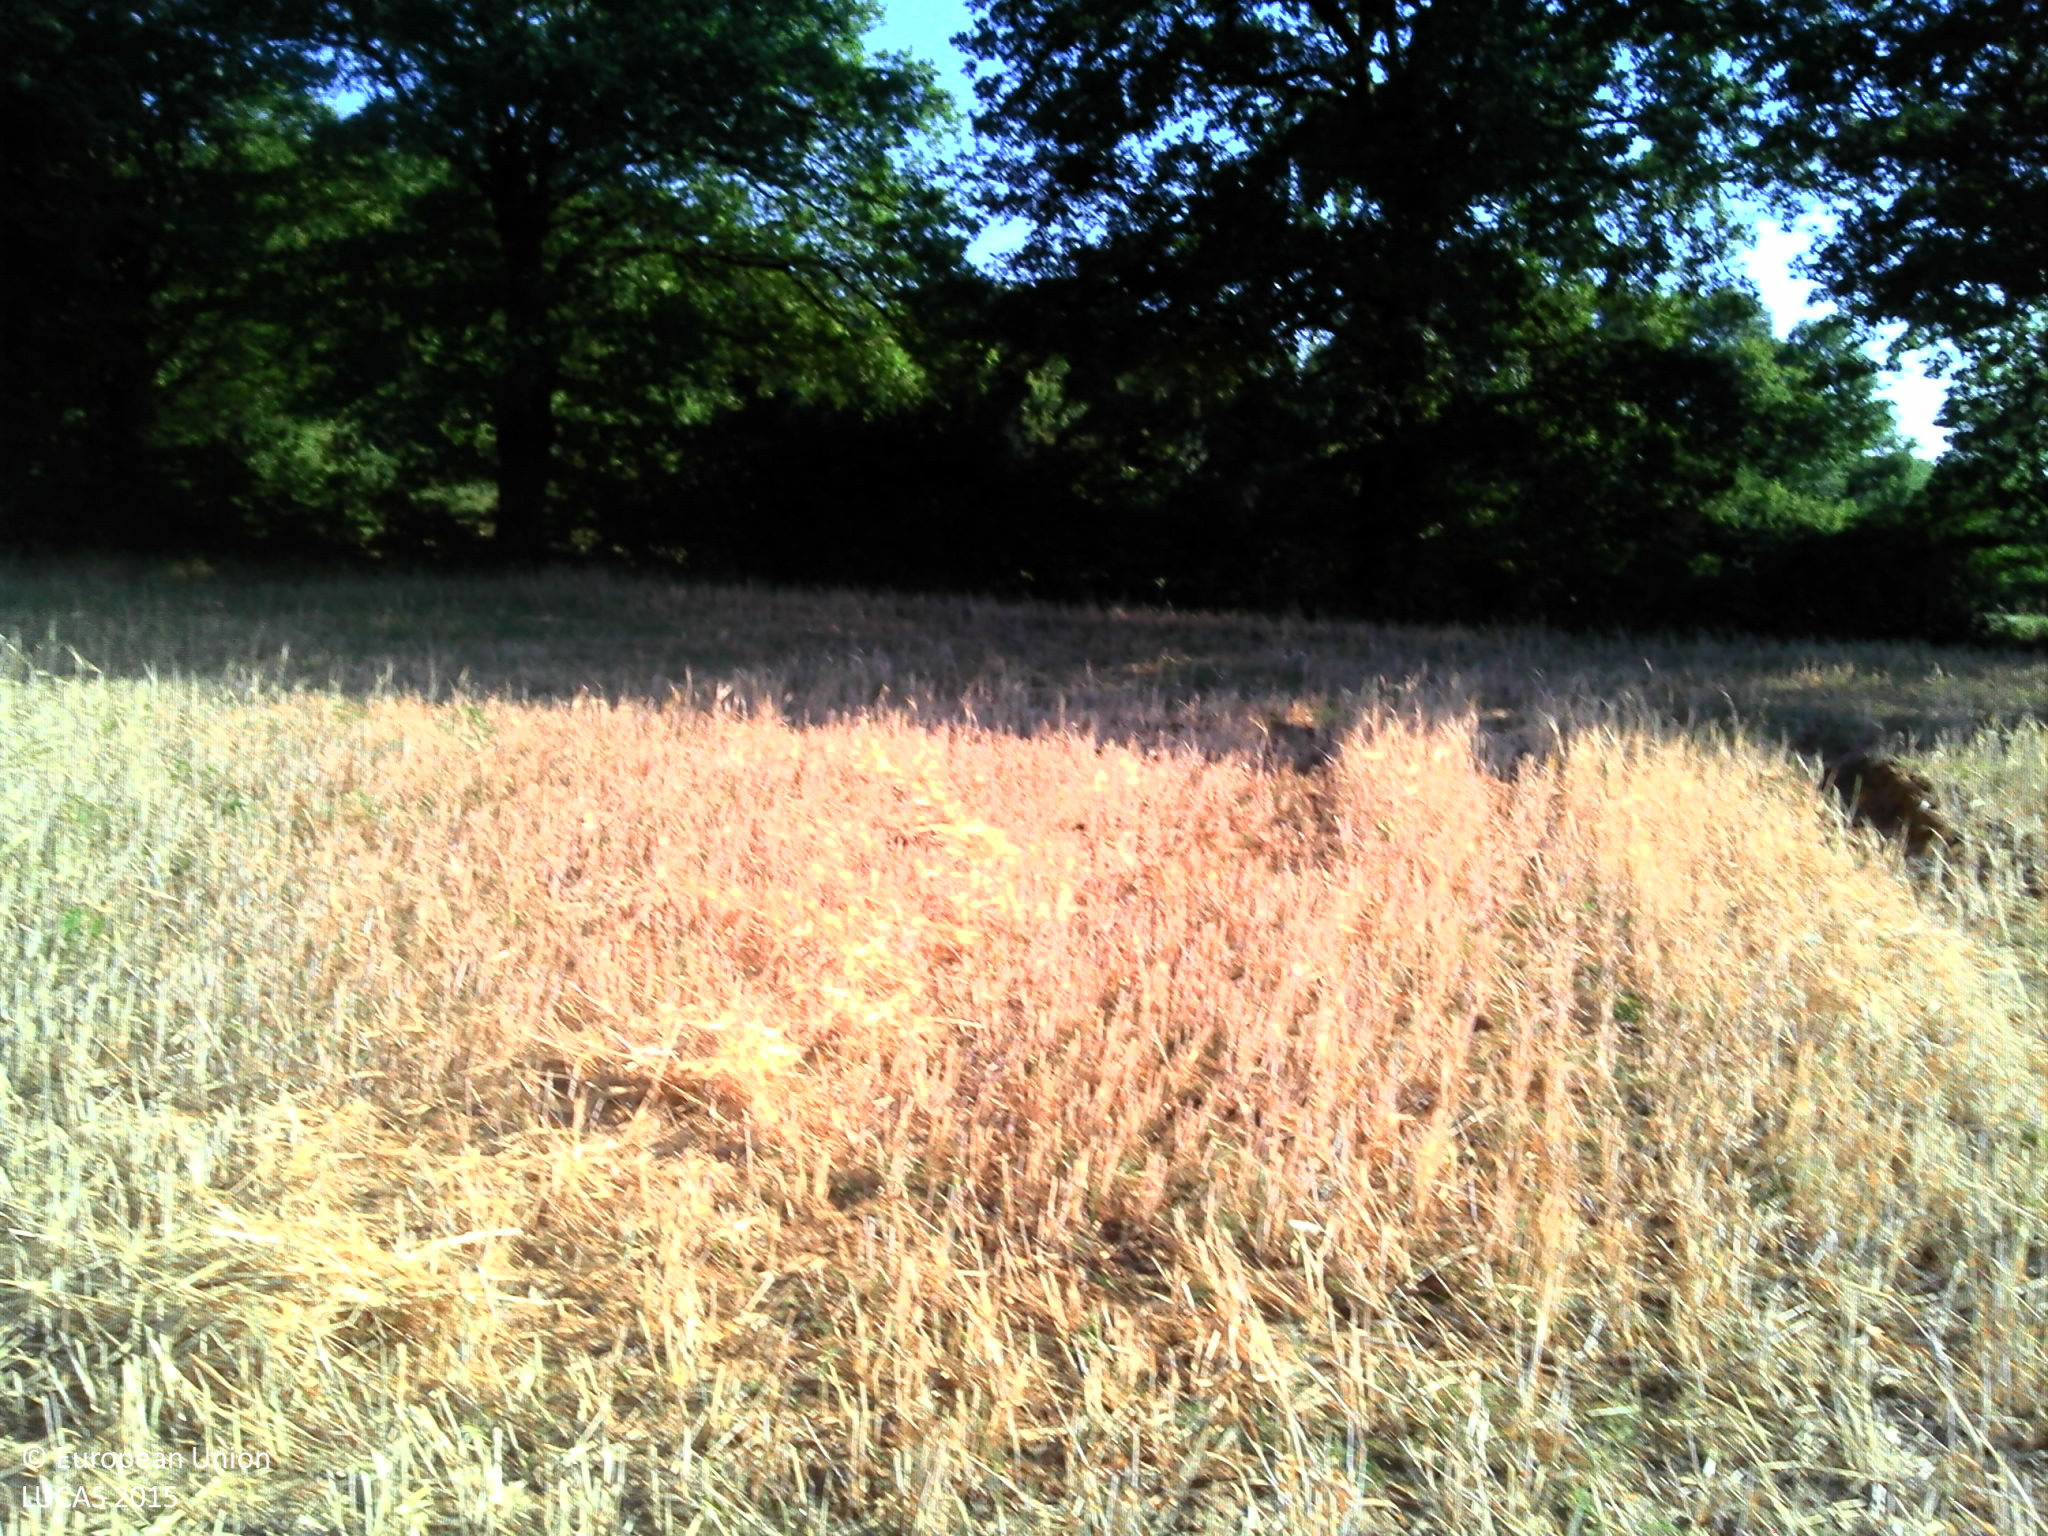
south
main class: Cropland
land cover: Barley
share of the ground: > 75 %
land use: Agriculture (excluding fallow land and kitchen gardens)
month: July
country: FR
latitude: 46.6341
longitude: 2.2999
